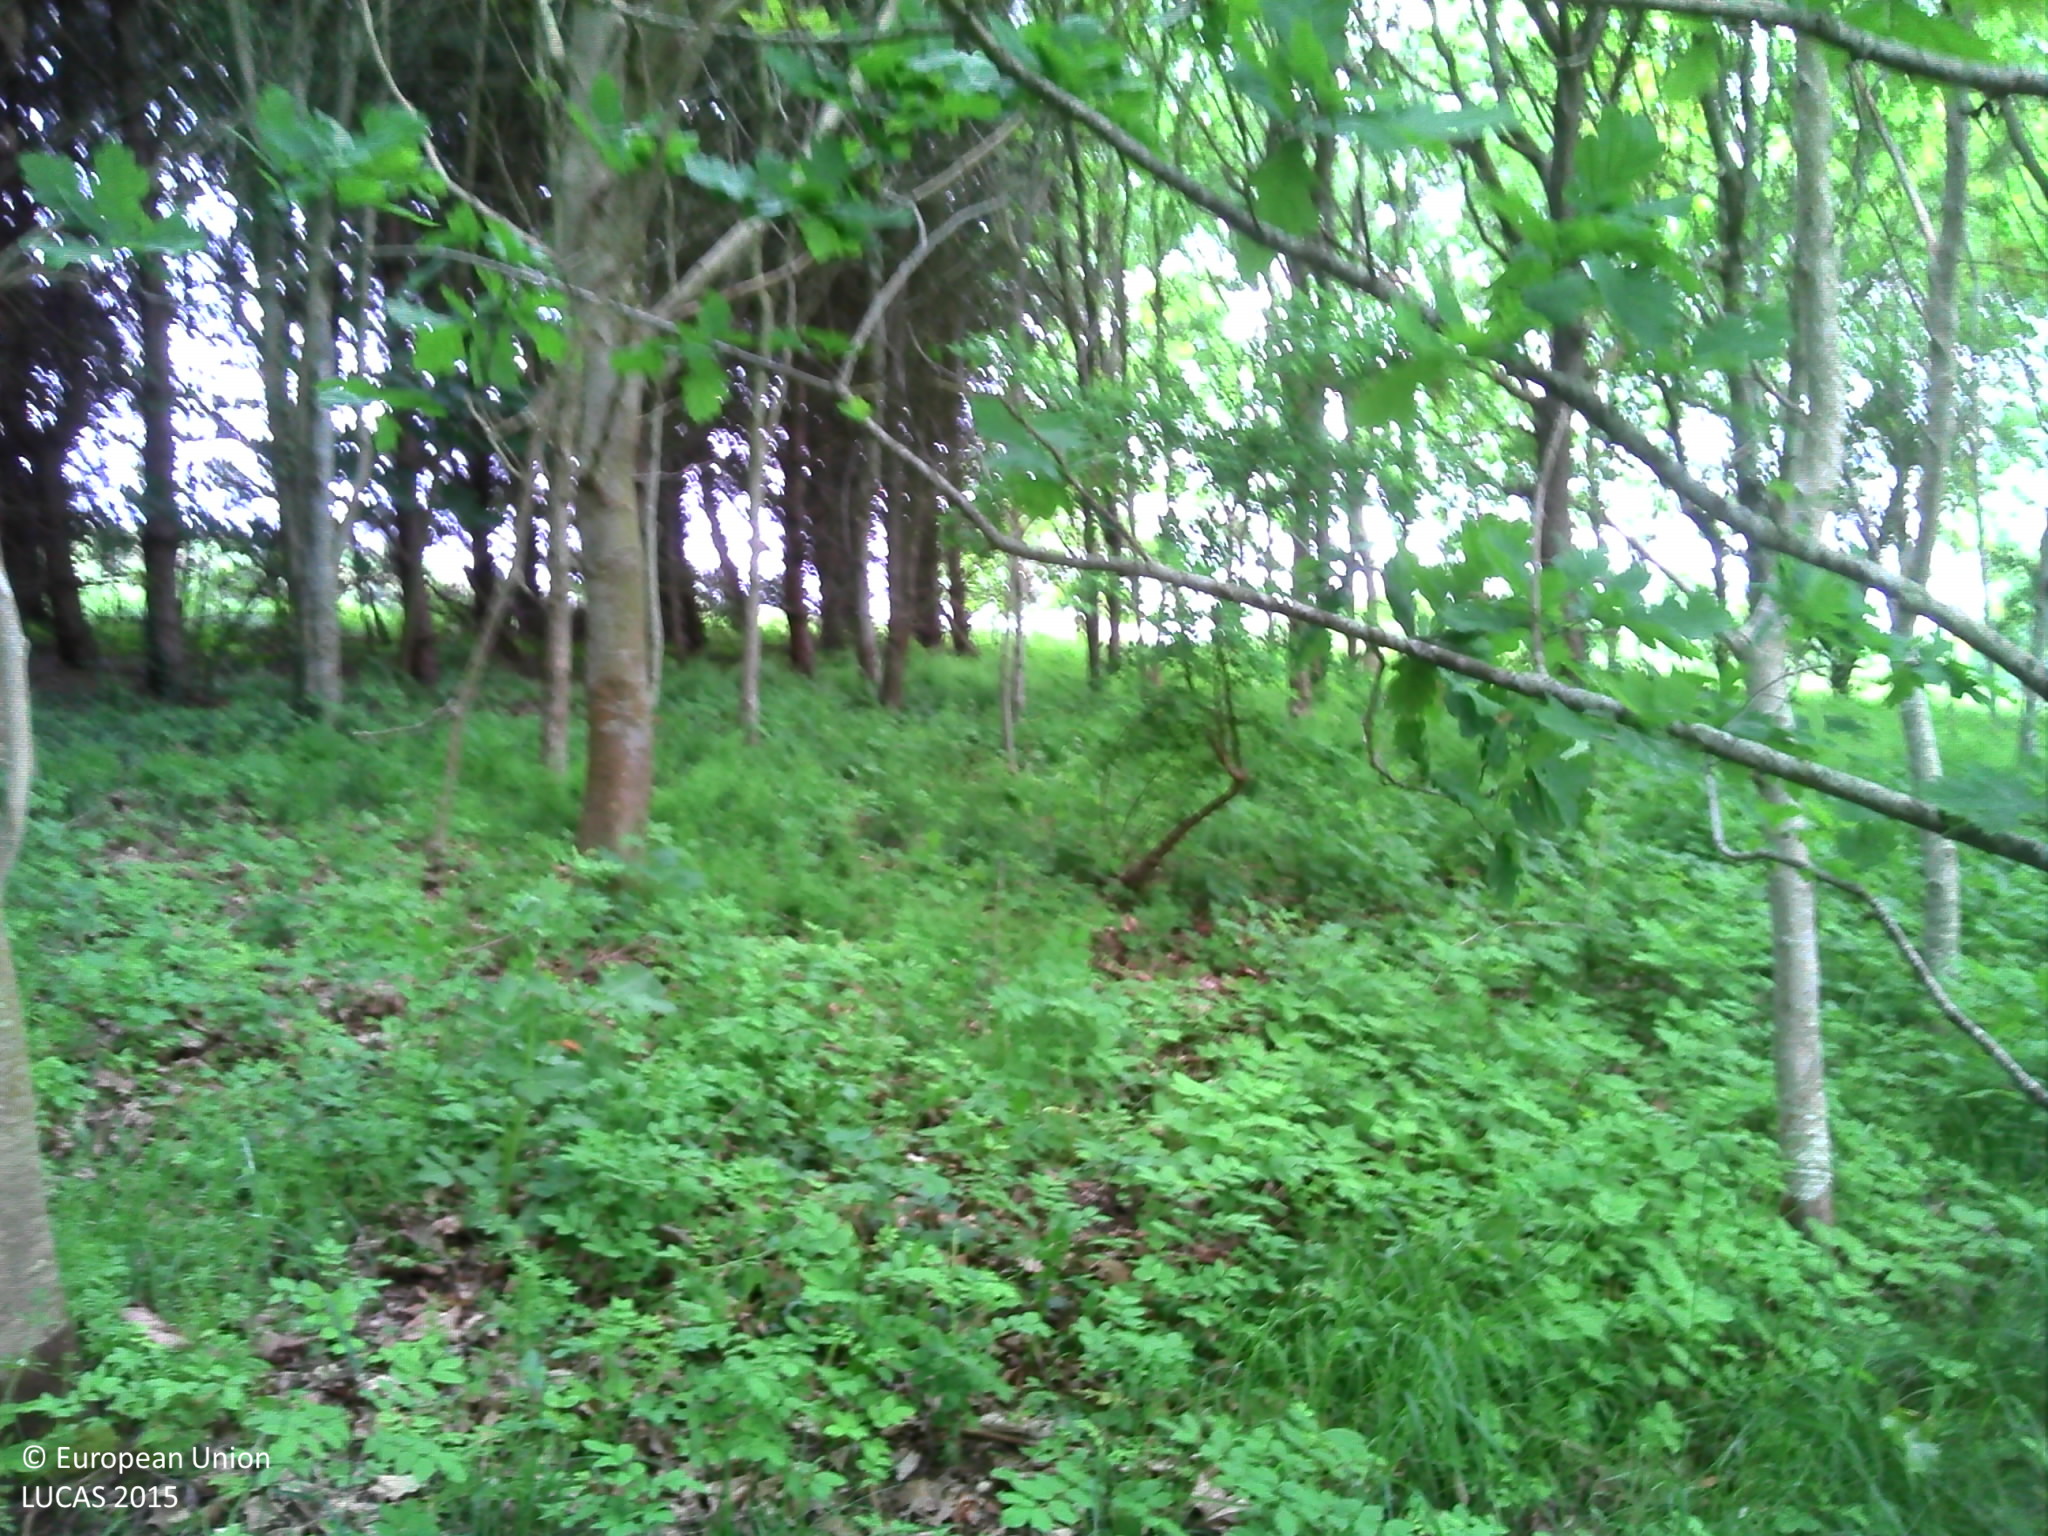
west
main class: Woodland
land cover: Broadleaved woodland
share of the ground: > 75 %
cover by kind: broadleaved forest trees 85 %, shrubs 10 %, herbaceous plants 5 %
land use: Forestry
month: May
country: FR
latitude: 49.3107
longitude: 0.0242
